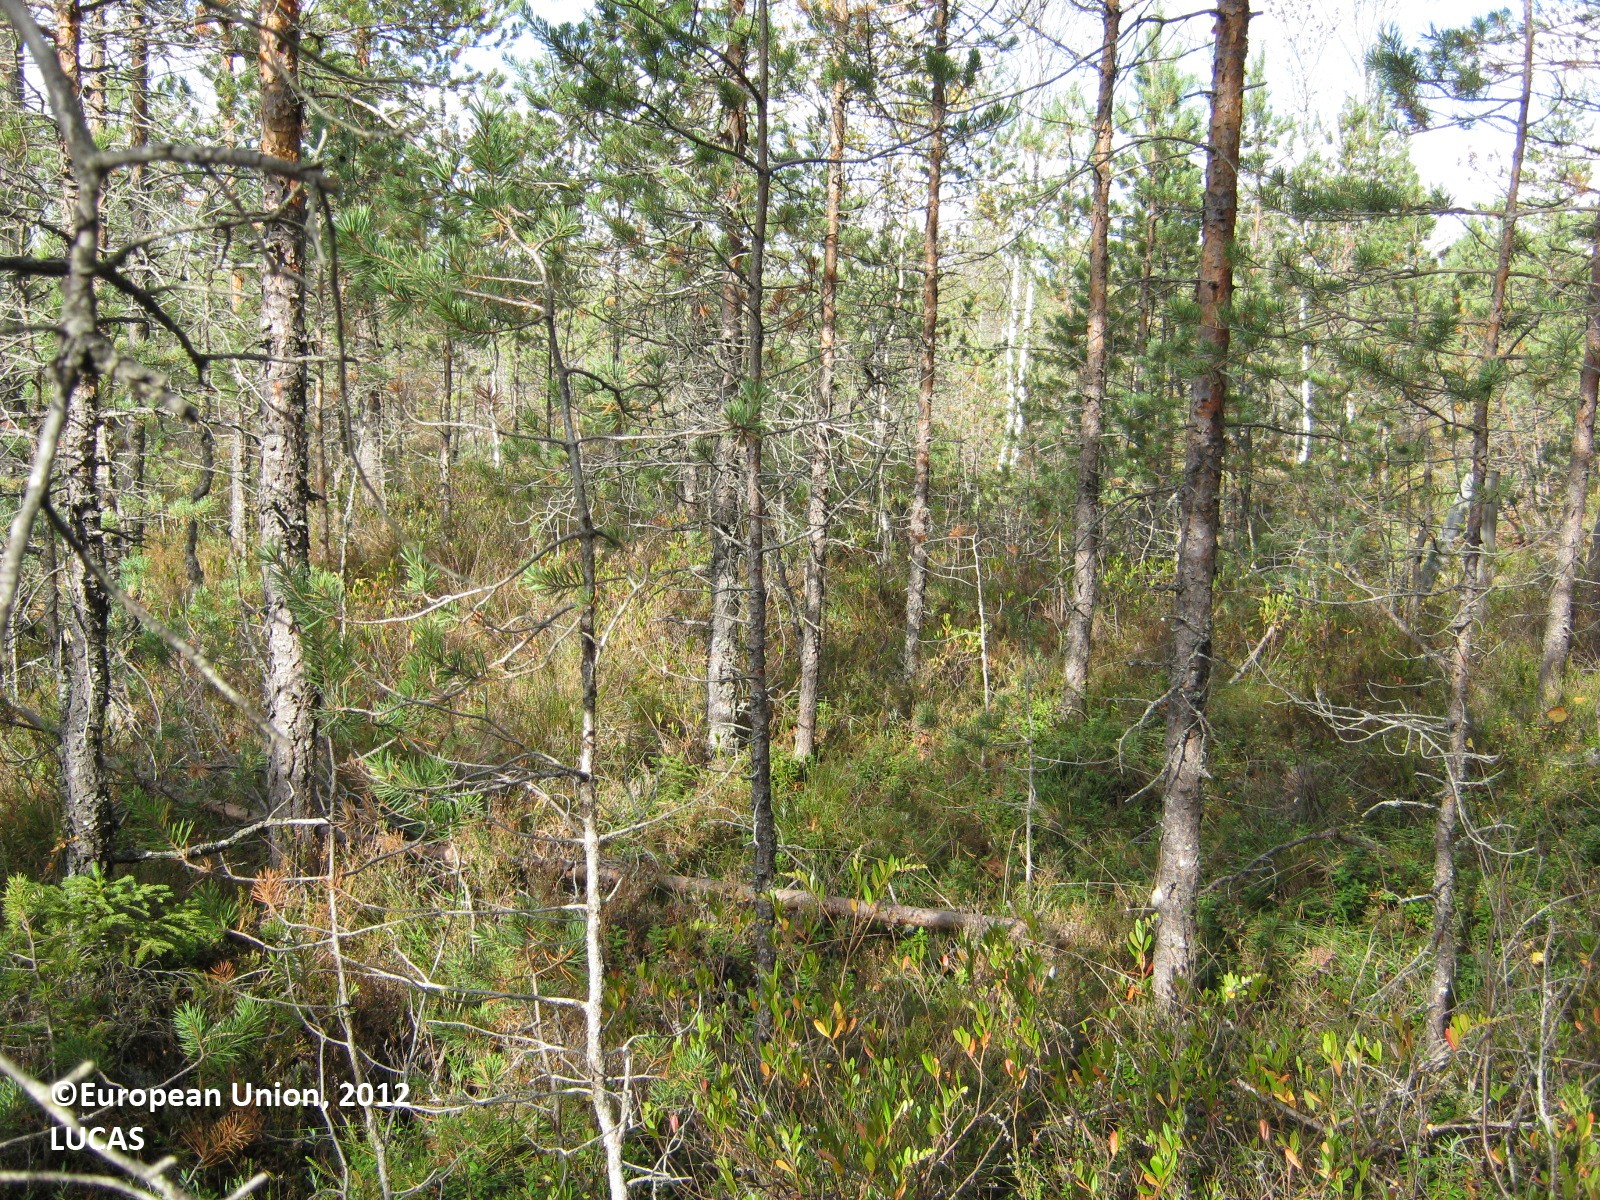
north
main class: Woodland
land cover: Pine dominated coniferous woodland
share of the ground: 50 - 75 %
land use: Forestry
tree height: < 5 m
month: September
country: FI
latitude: 60.9818
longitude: 28.2253
